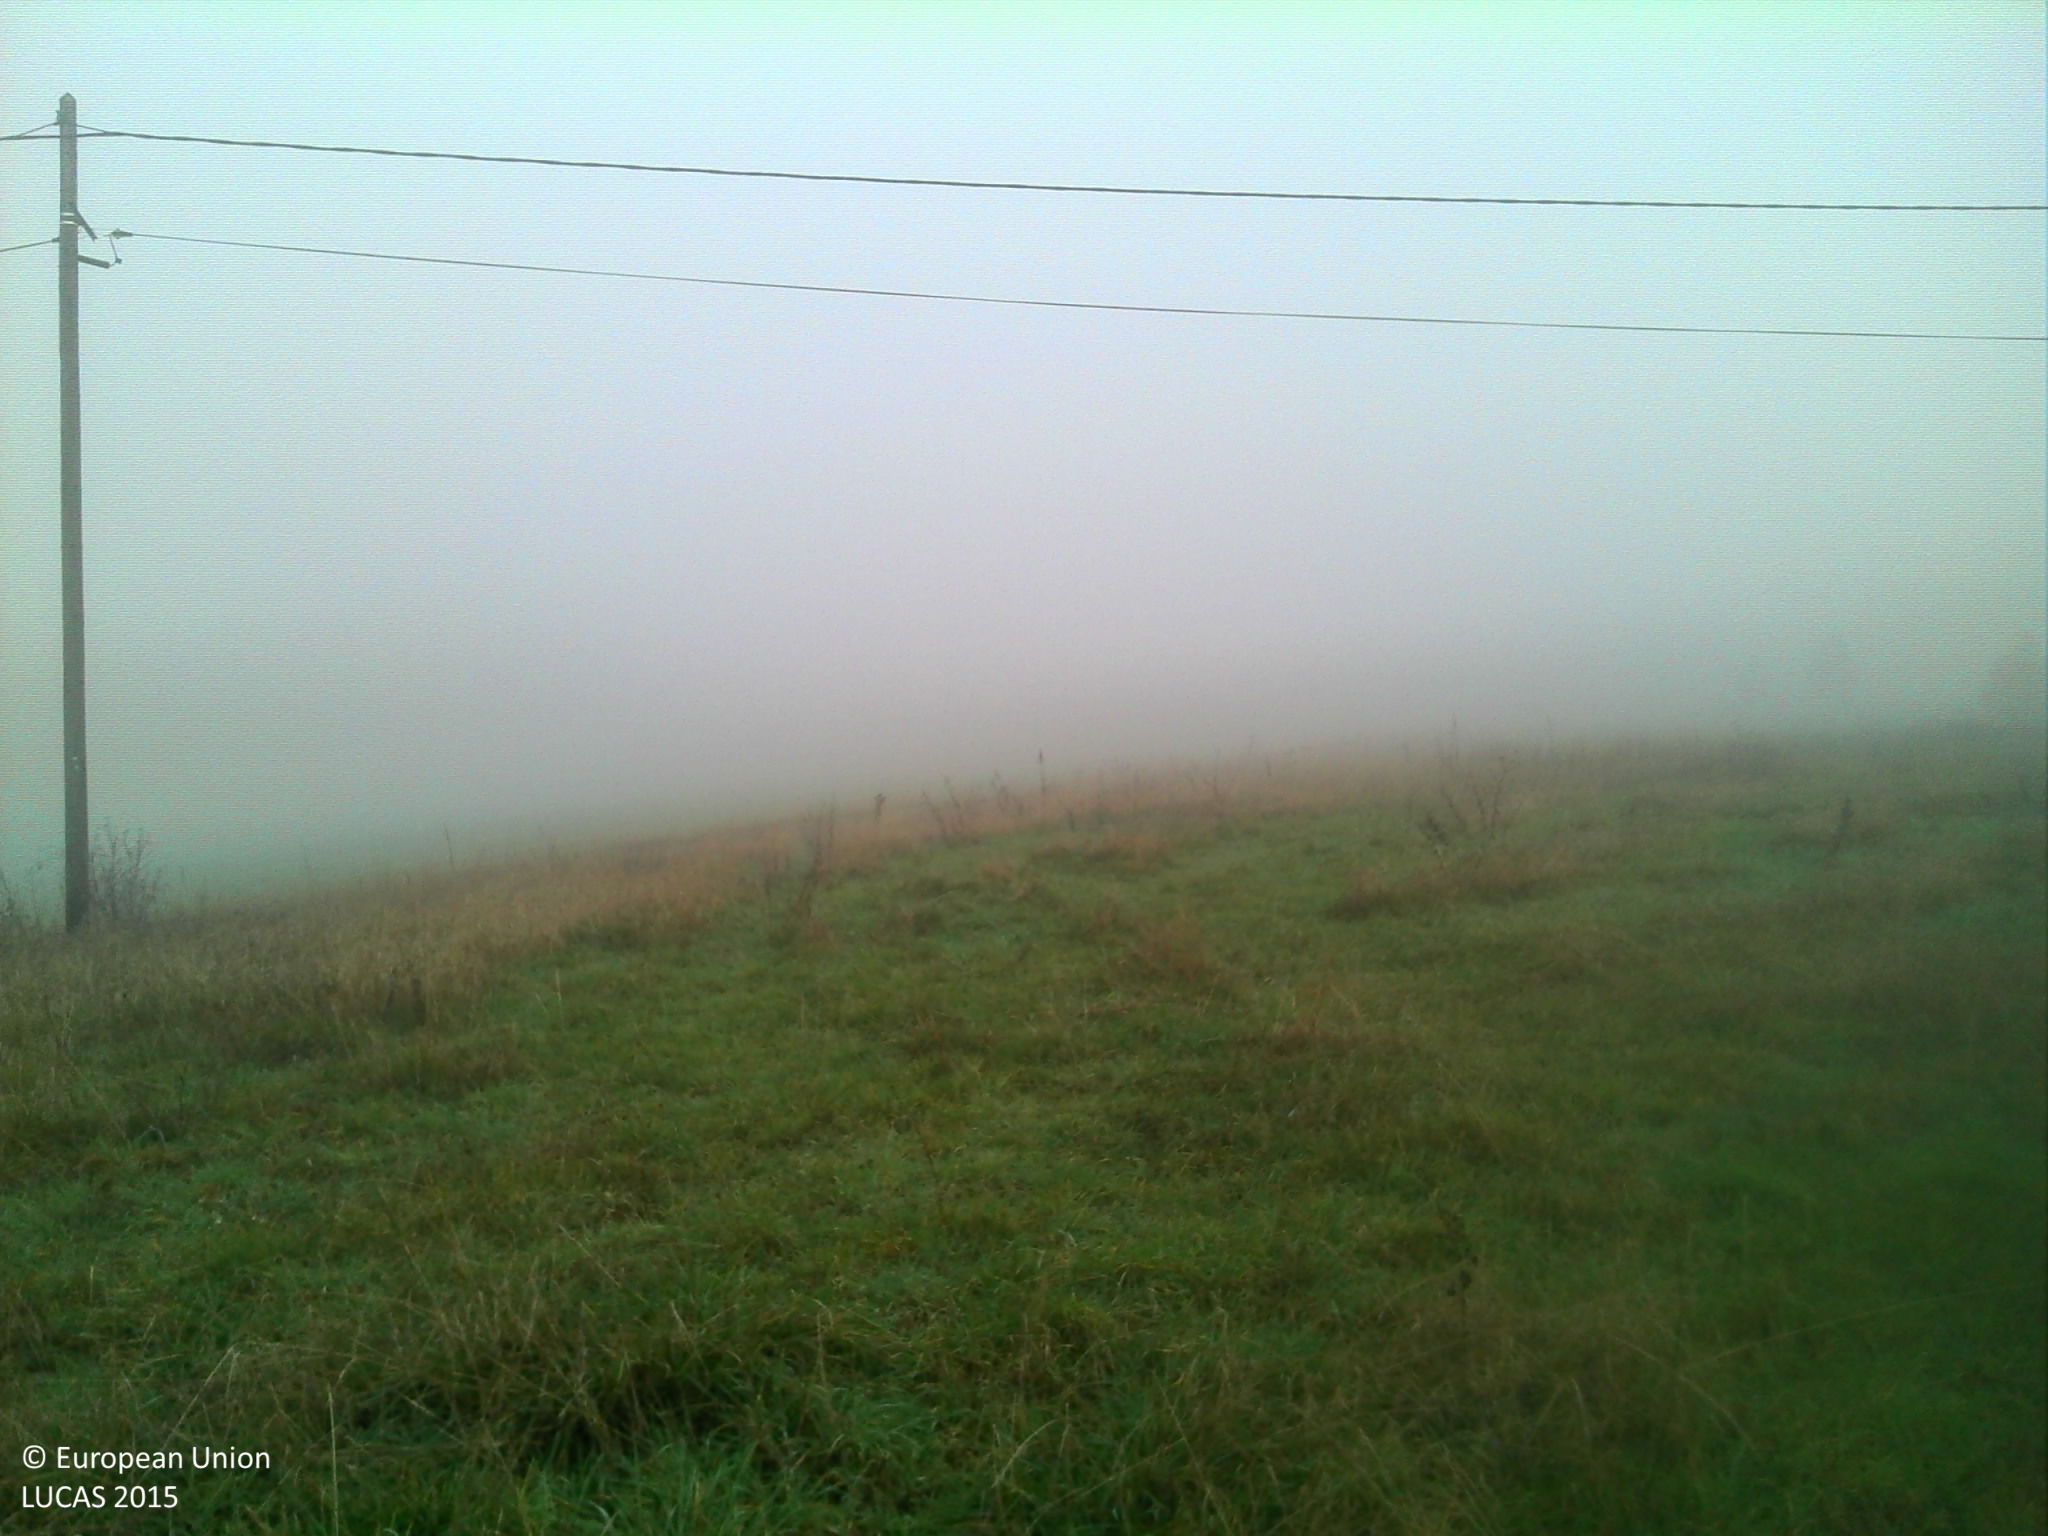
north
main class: Grassland
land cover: Grassland without tree/shrub cover
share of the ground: > 75 %
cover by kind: herbaceous plants 100 %
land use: Agriculture (excluding fallow land and kitchen gardens)
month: December
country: FR
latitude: 45.1707
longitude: 5.0302
